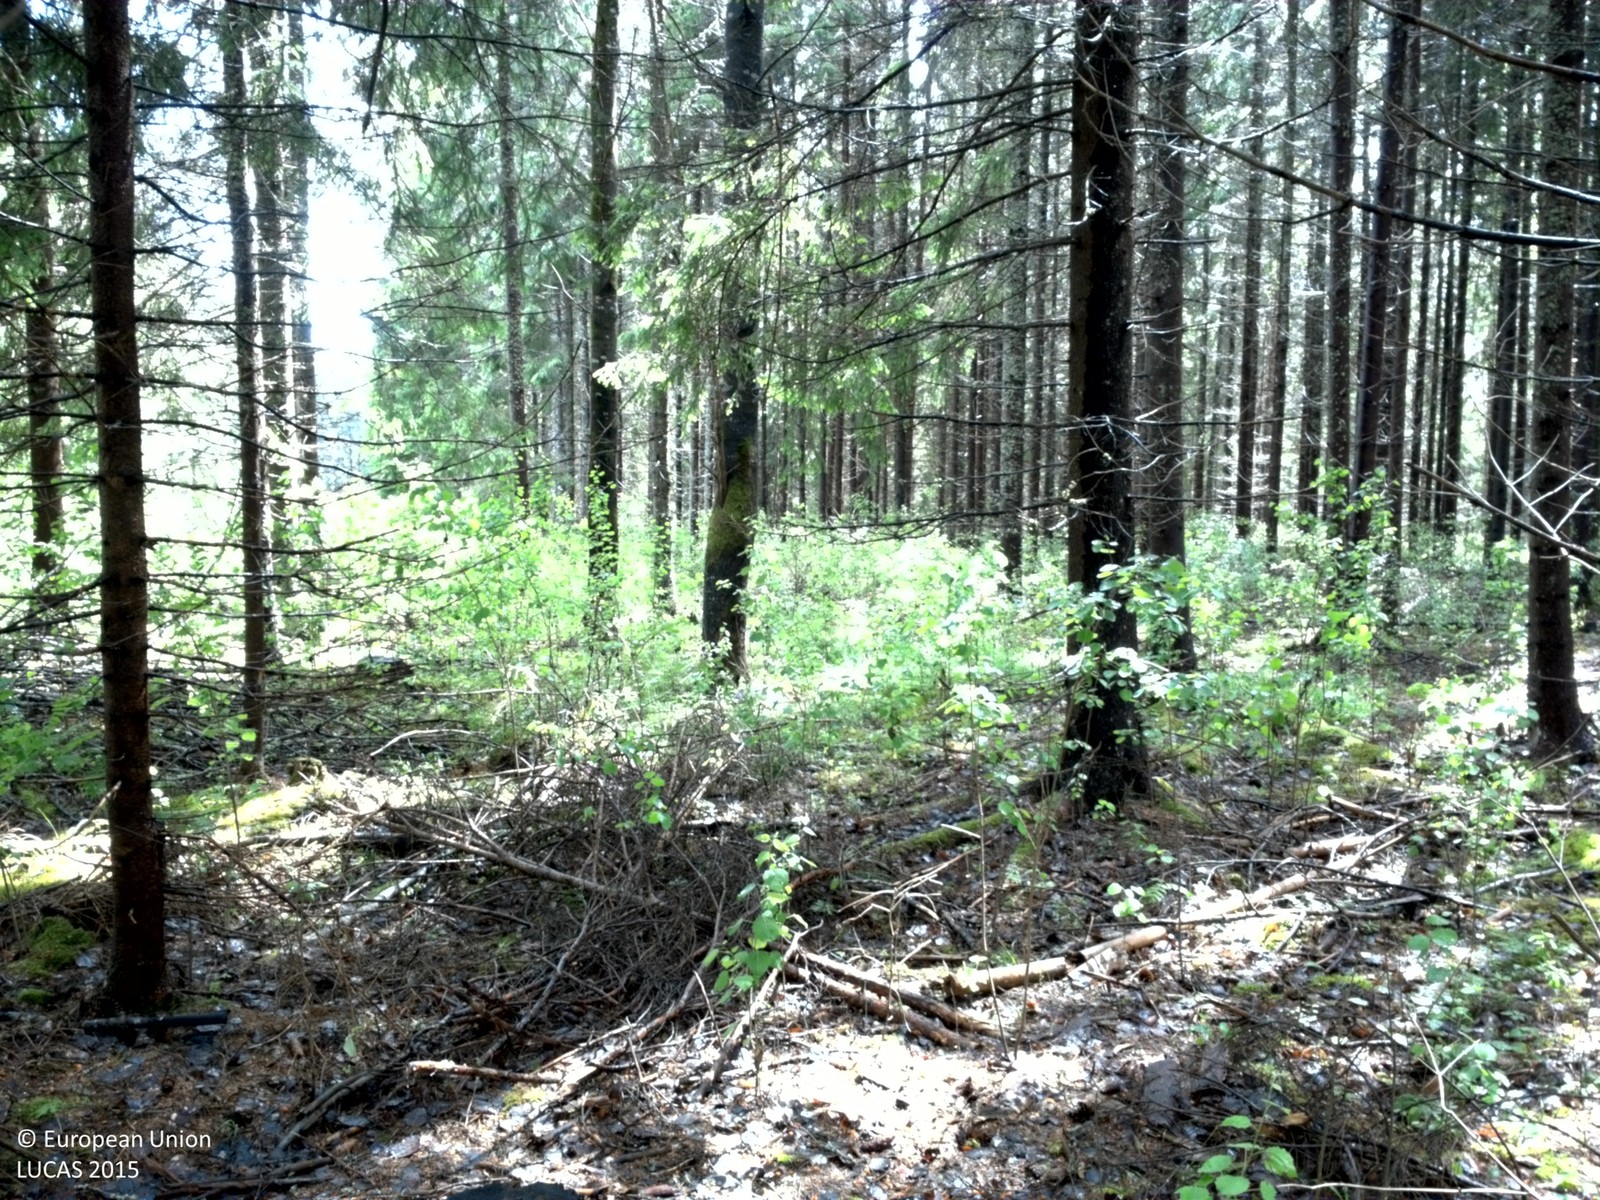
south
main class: Woodland
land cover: Spruce dominated coniferous woodland
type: boreal forest
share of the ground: > 75 %
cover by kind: coniferous forest trees 85 %, broadleaved forest trees 5 %, herbaceous plants 5 %, lichens and mosses 5 %
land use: Forestry
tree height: > 5 m
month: June
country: SE
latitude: 59.8581
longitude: 17.0805
